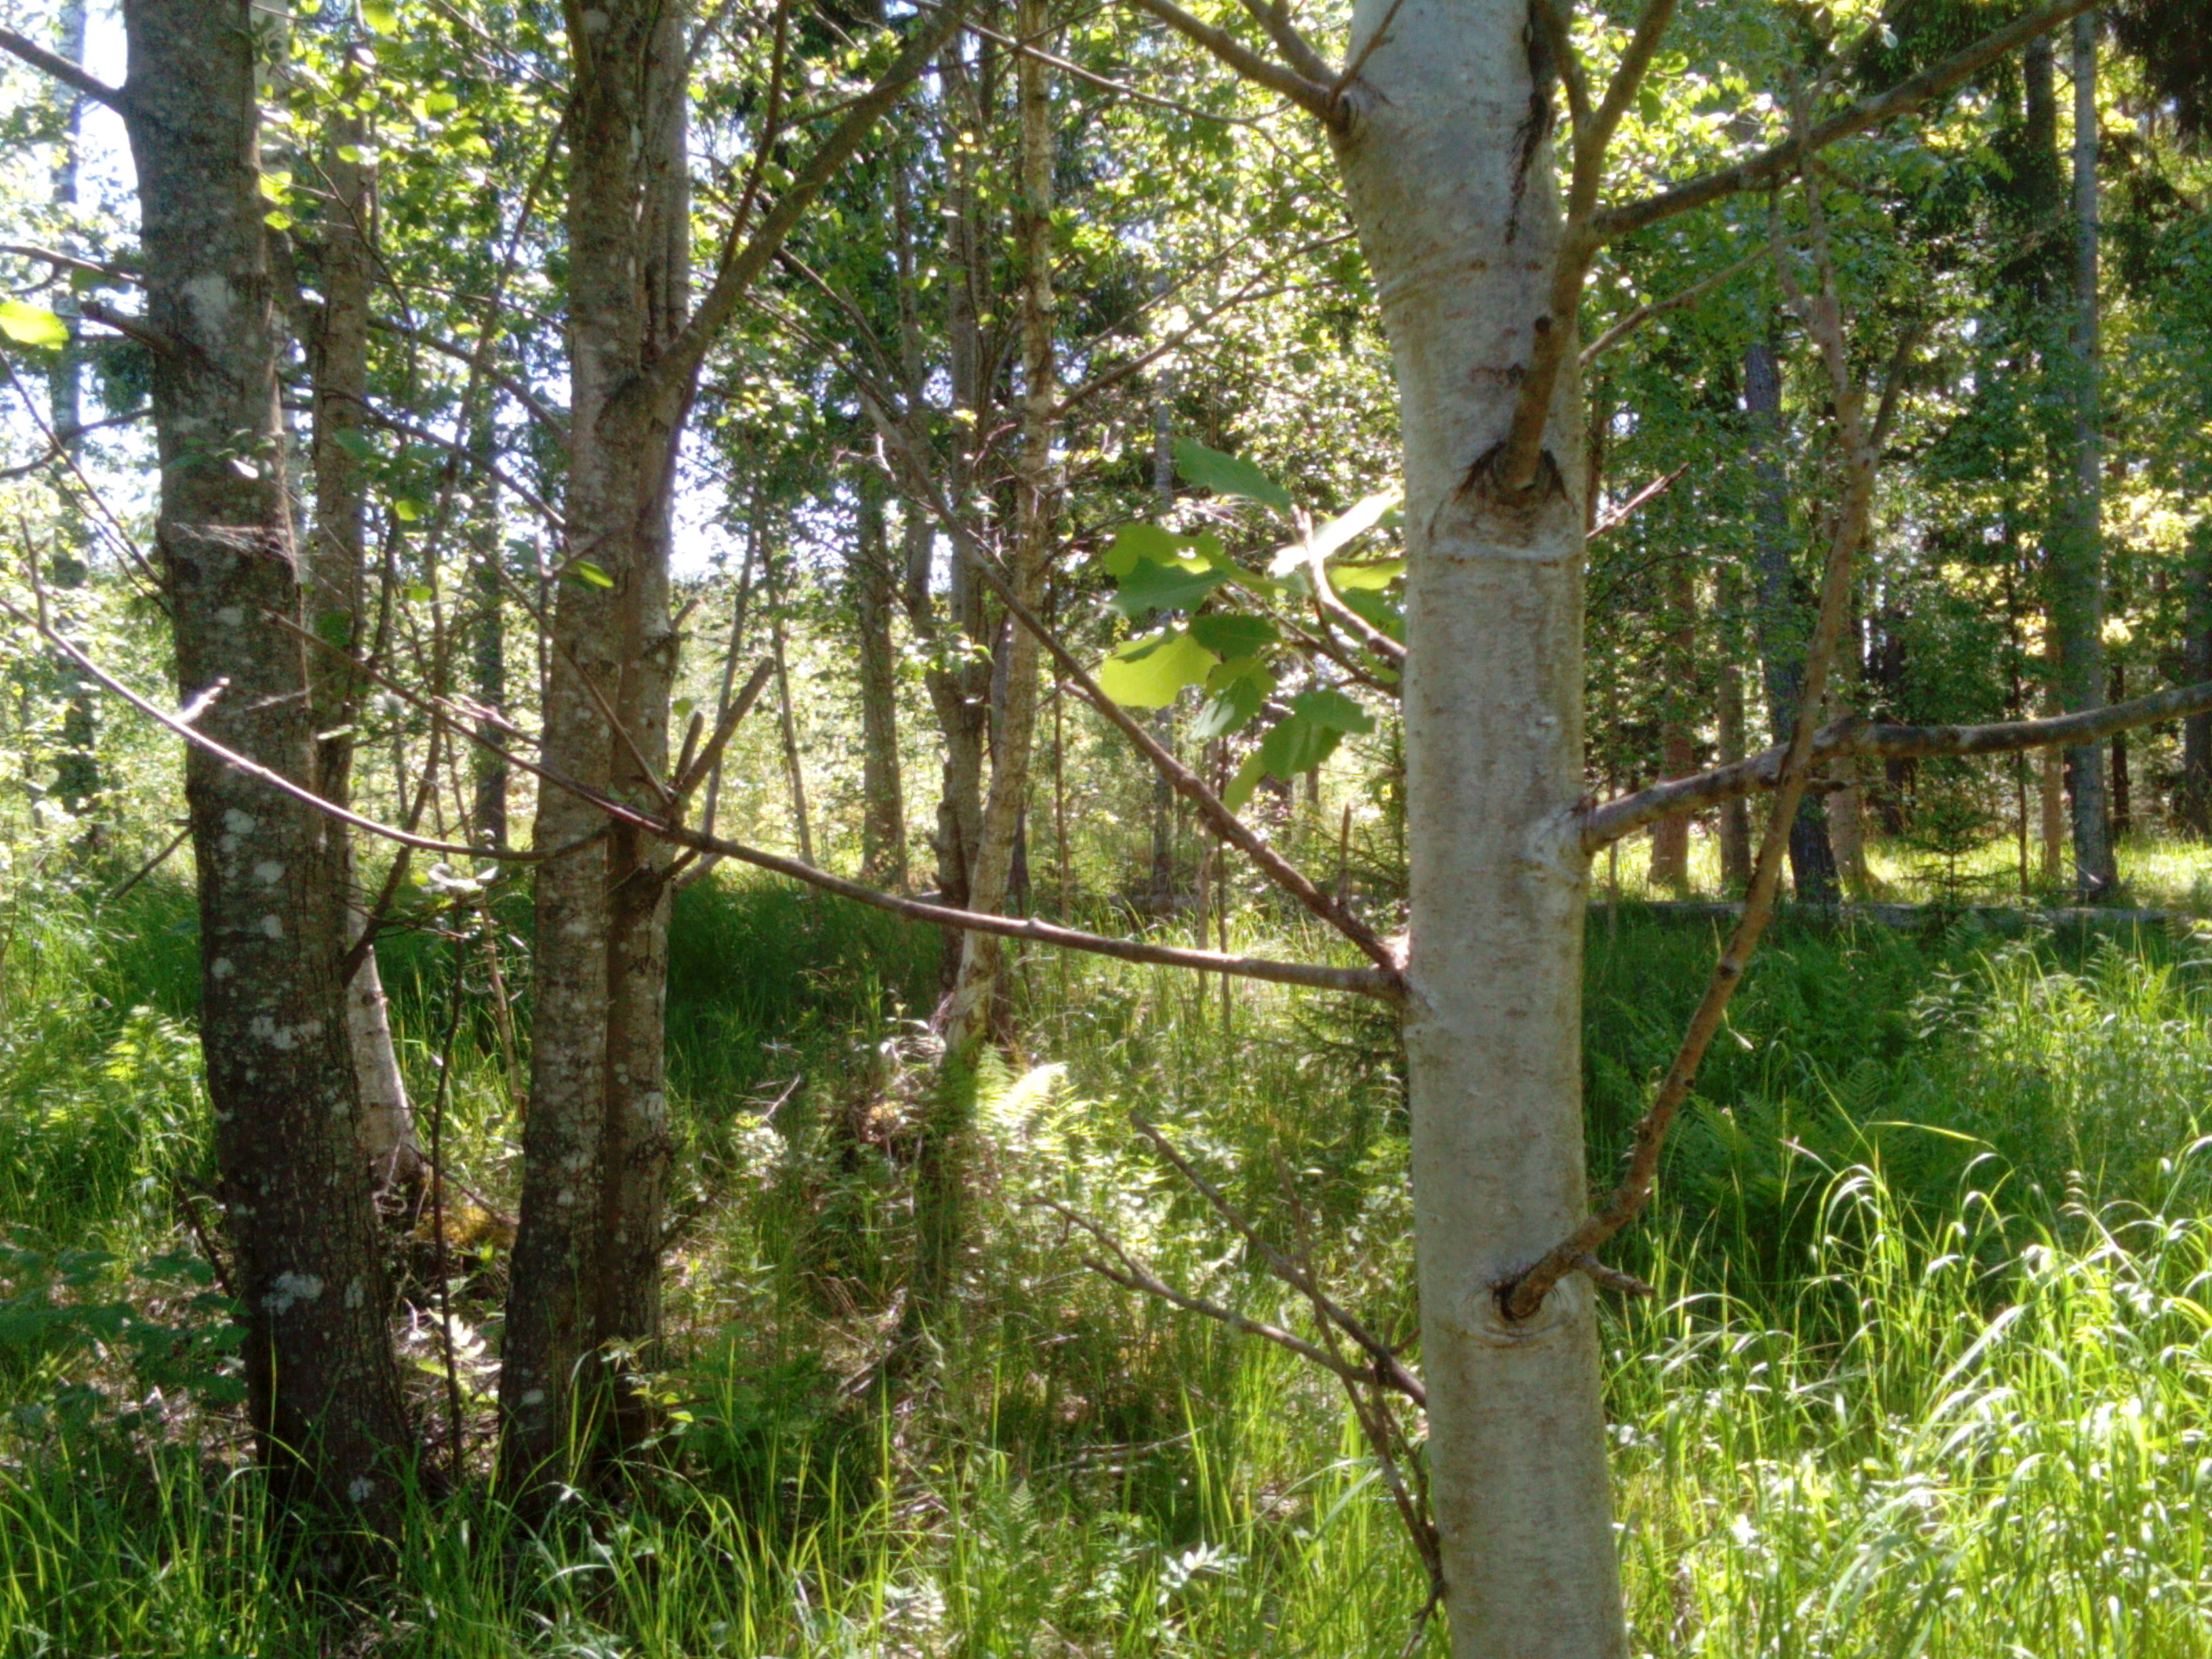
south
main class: Woodland
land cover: Broadleaved woodland
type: non-riverine alder, birch or aspen forest
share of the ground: 50 - 75 %
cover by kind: broadleaved forest trees 45 %, herbaceous plants 40 %, shrubs 10 %, coniferous forest trees 5 %
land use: Forestry
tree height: > 5 m
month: June
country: LV
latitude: 56.6379
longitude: 22.2319
